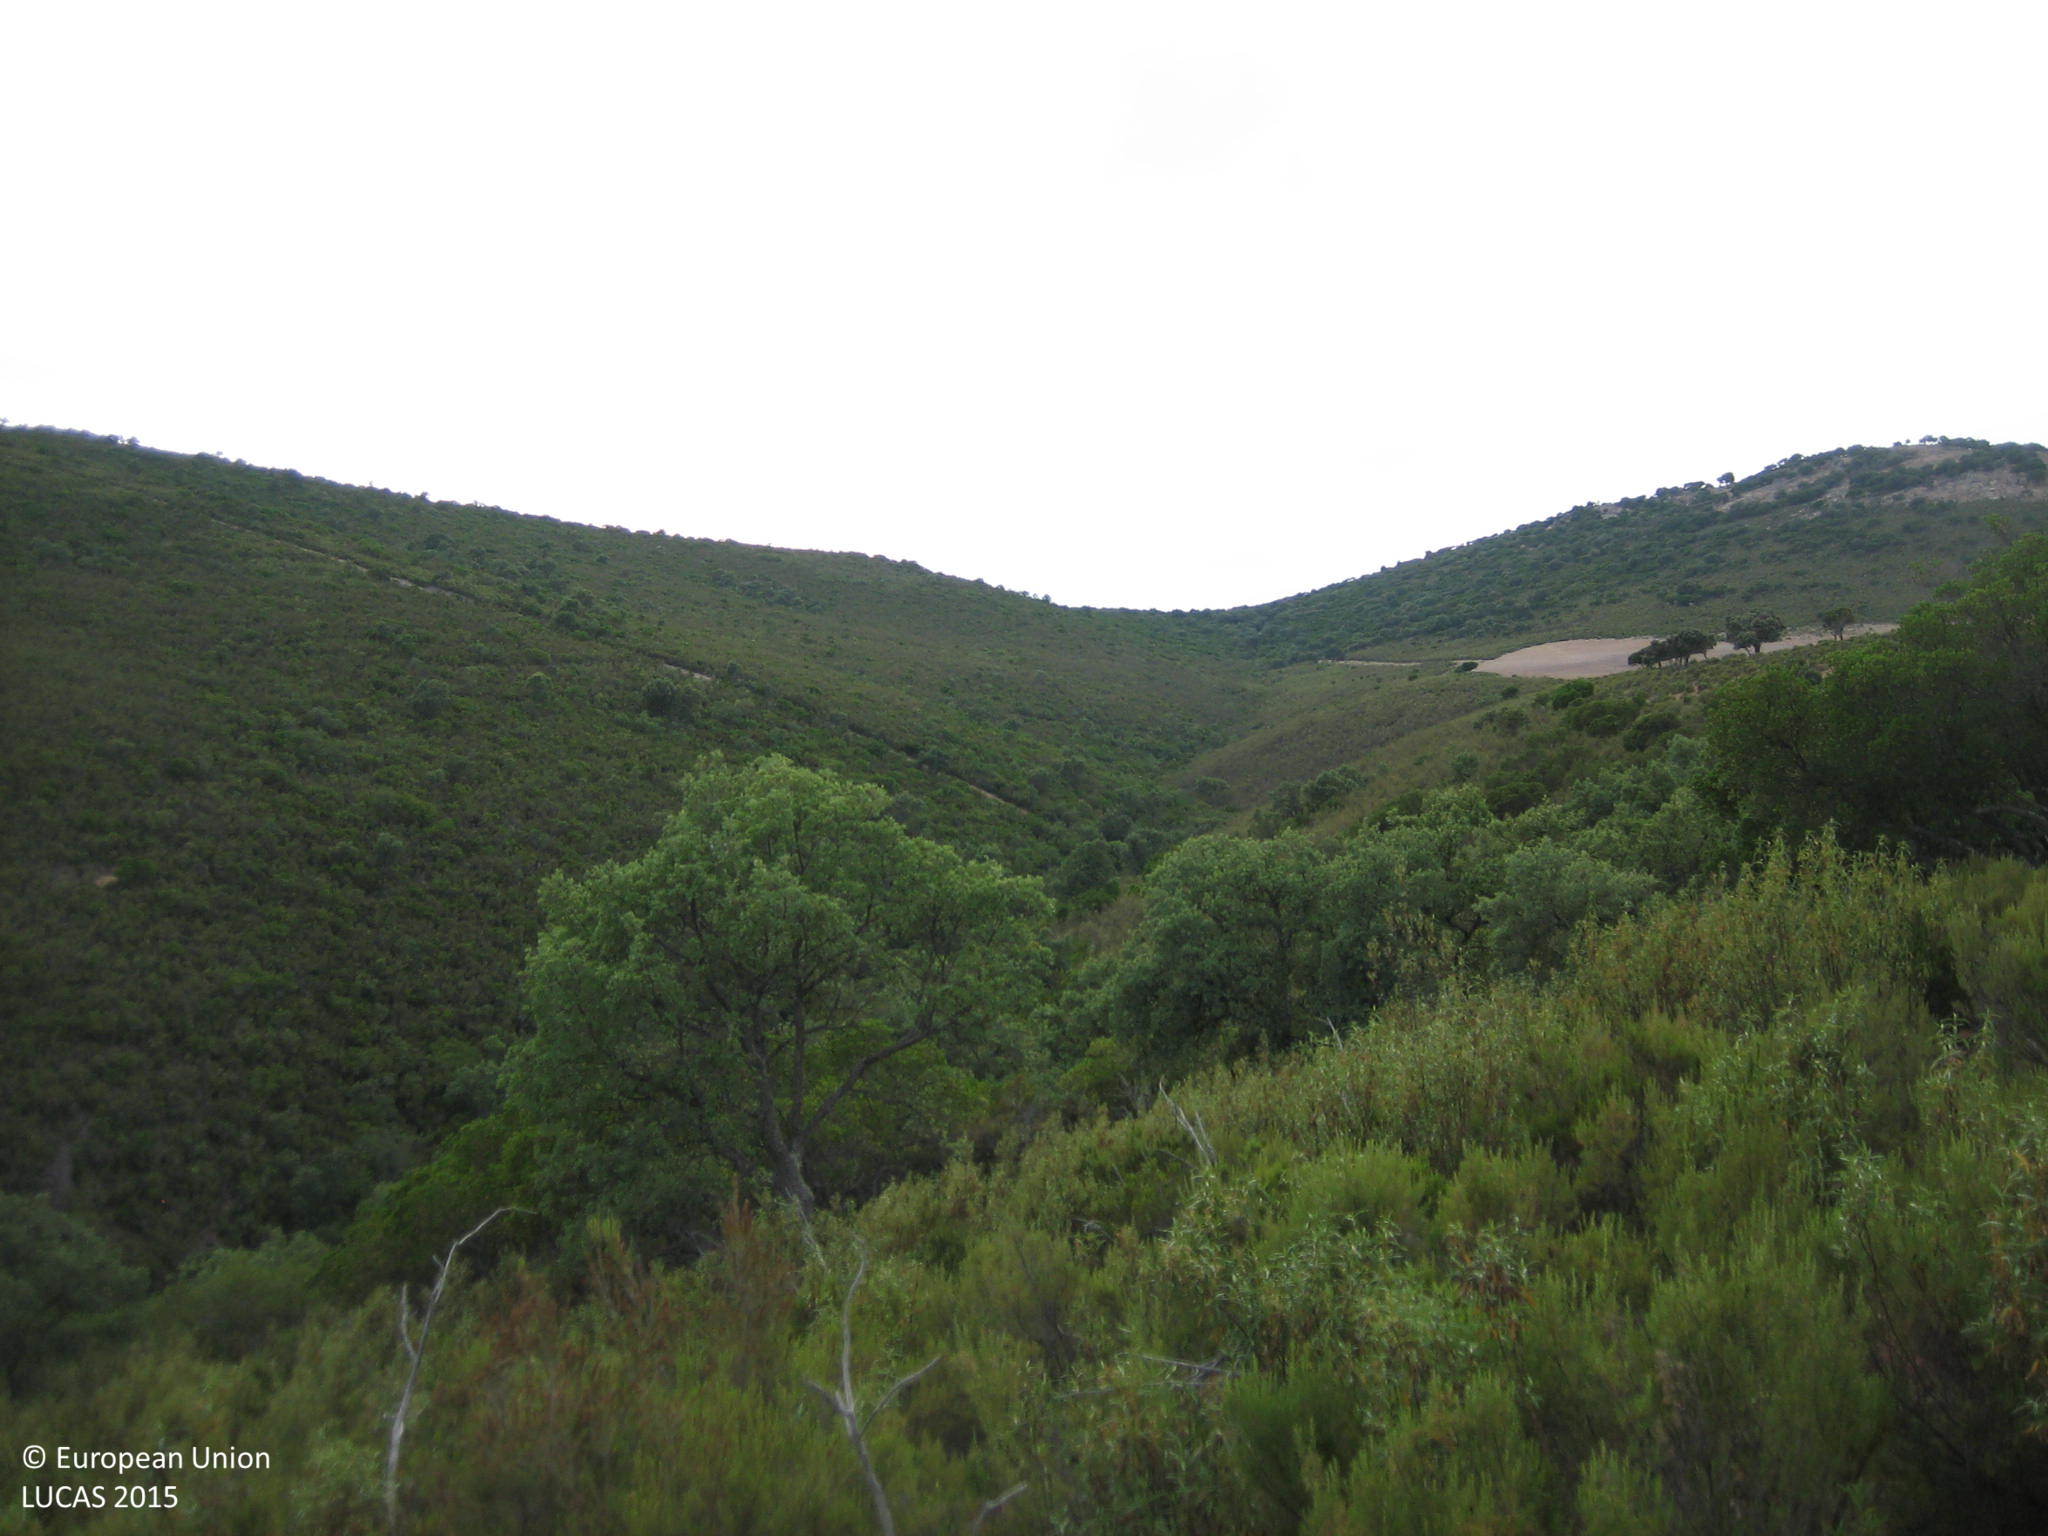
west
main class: Shrubland
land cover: Shrubland with sparse tree cover
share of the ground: > 75 %
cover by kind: shrubs 90 %, broadleaved forest trees 5 %, herbaceous plants 5 %
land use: Semi-natural and natural areas not in use
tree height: > 5 m
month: June
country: ES
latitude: 39.1294
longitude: -4.7364
